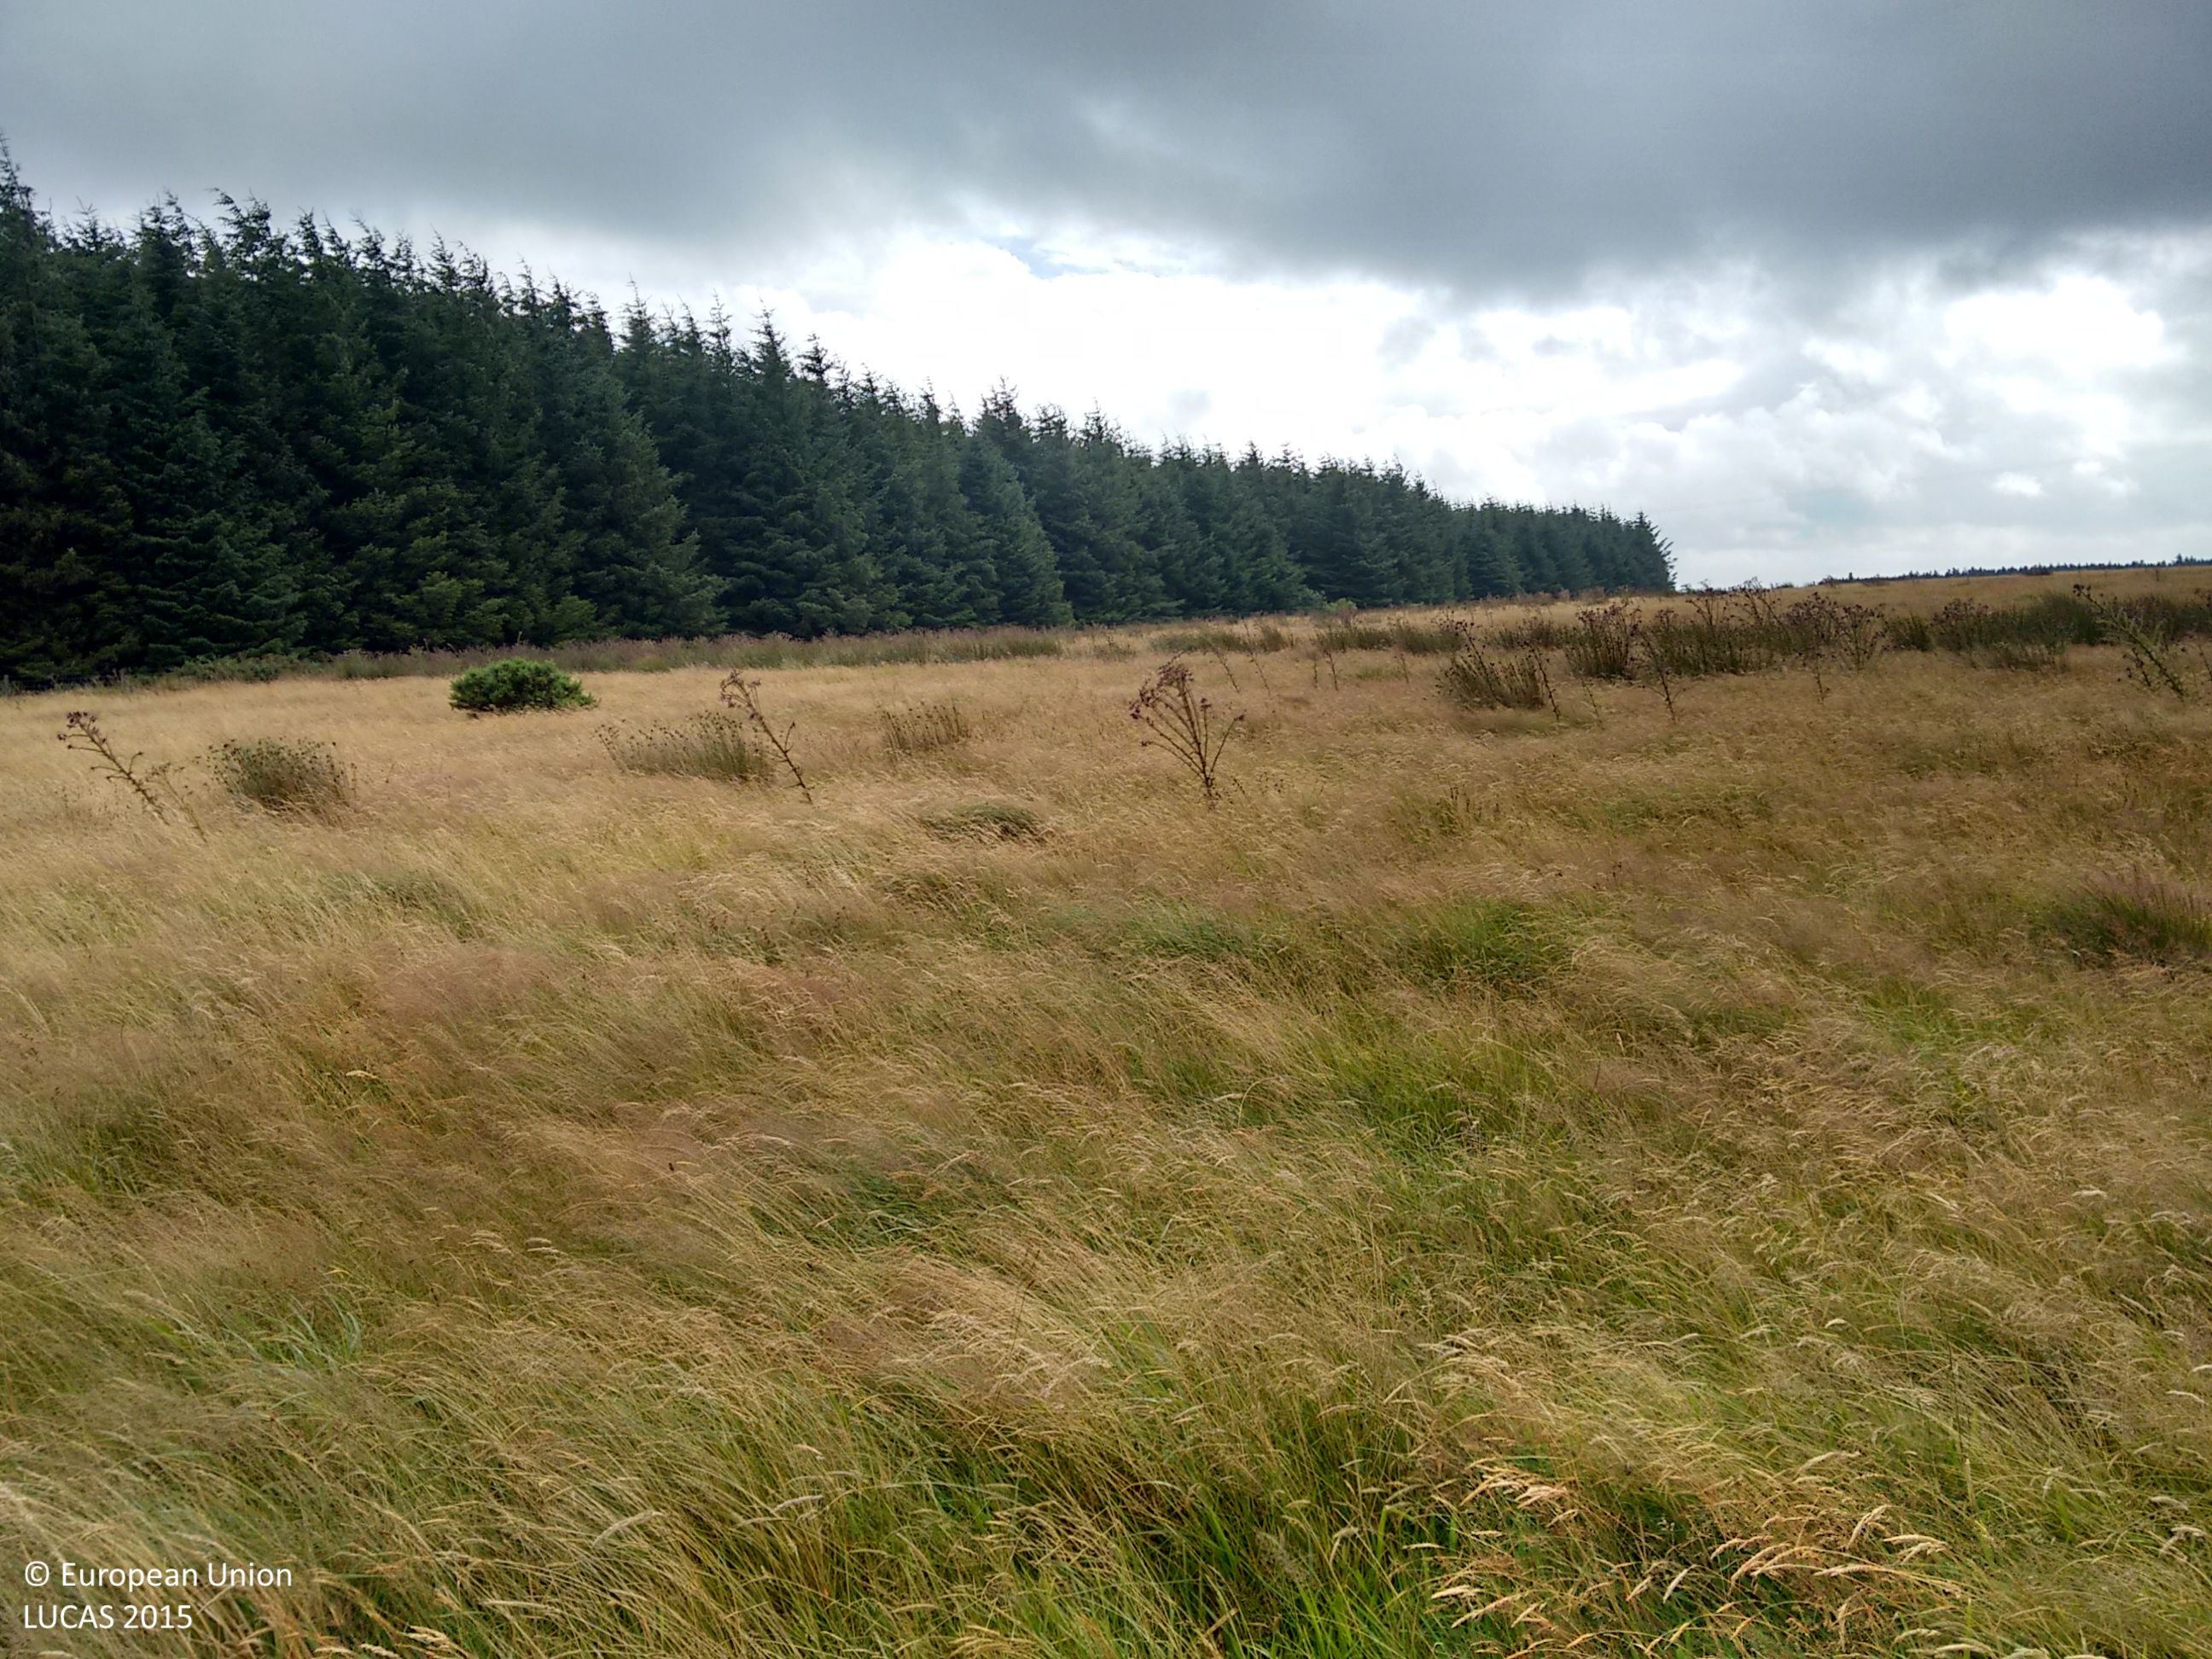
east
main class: Grassland
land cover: Grassland without tree/shrub cover
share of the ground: > 75 %
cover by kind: herbaceous plants 100 %
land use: Agriculture (excluding fallow land and kitchen gardens)
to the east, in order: Grassland without tree/shrub cover; Fences; Grassland without tree/shrub cover; Spruce dominated coniferous woodland; Grassland with sparse tree/shrub cover; Electric lines; Fences; Spruce dominated coniferous woodland
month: August
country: GB
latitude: 51.9810
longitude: -4.4455
